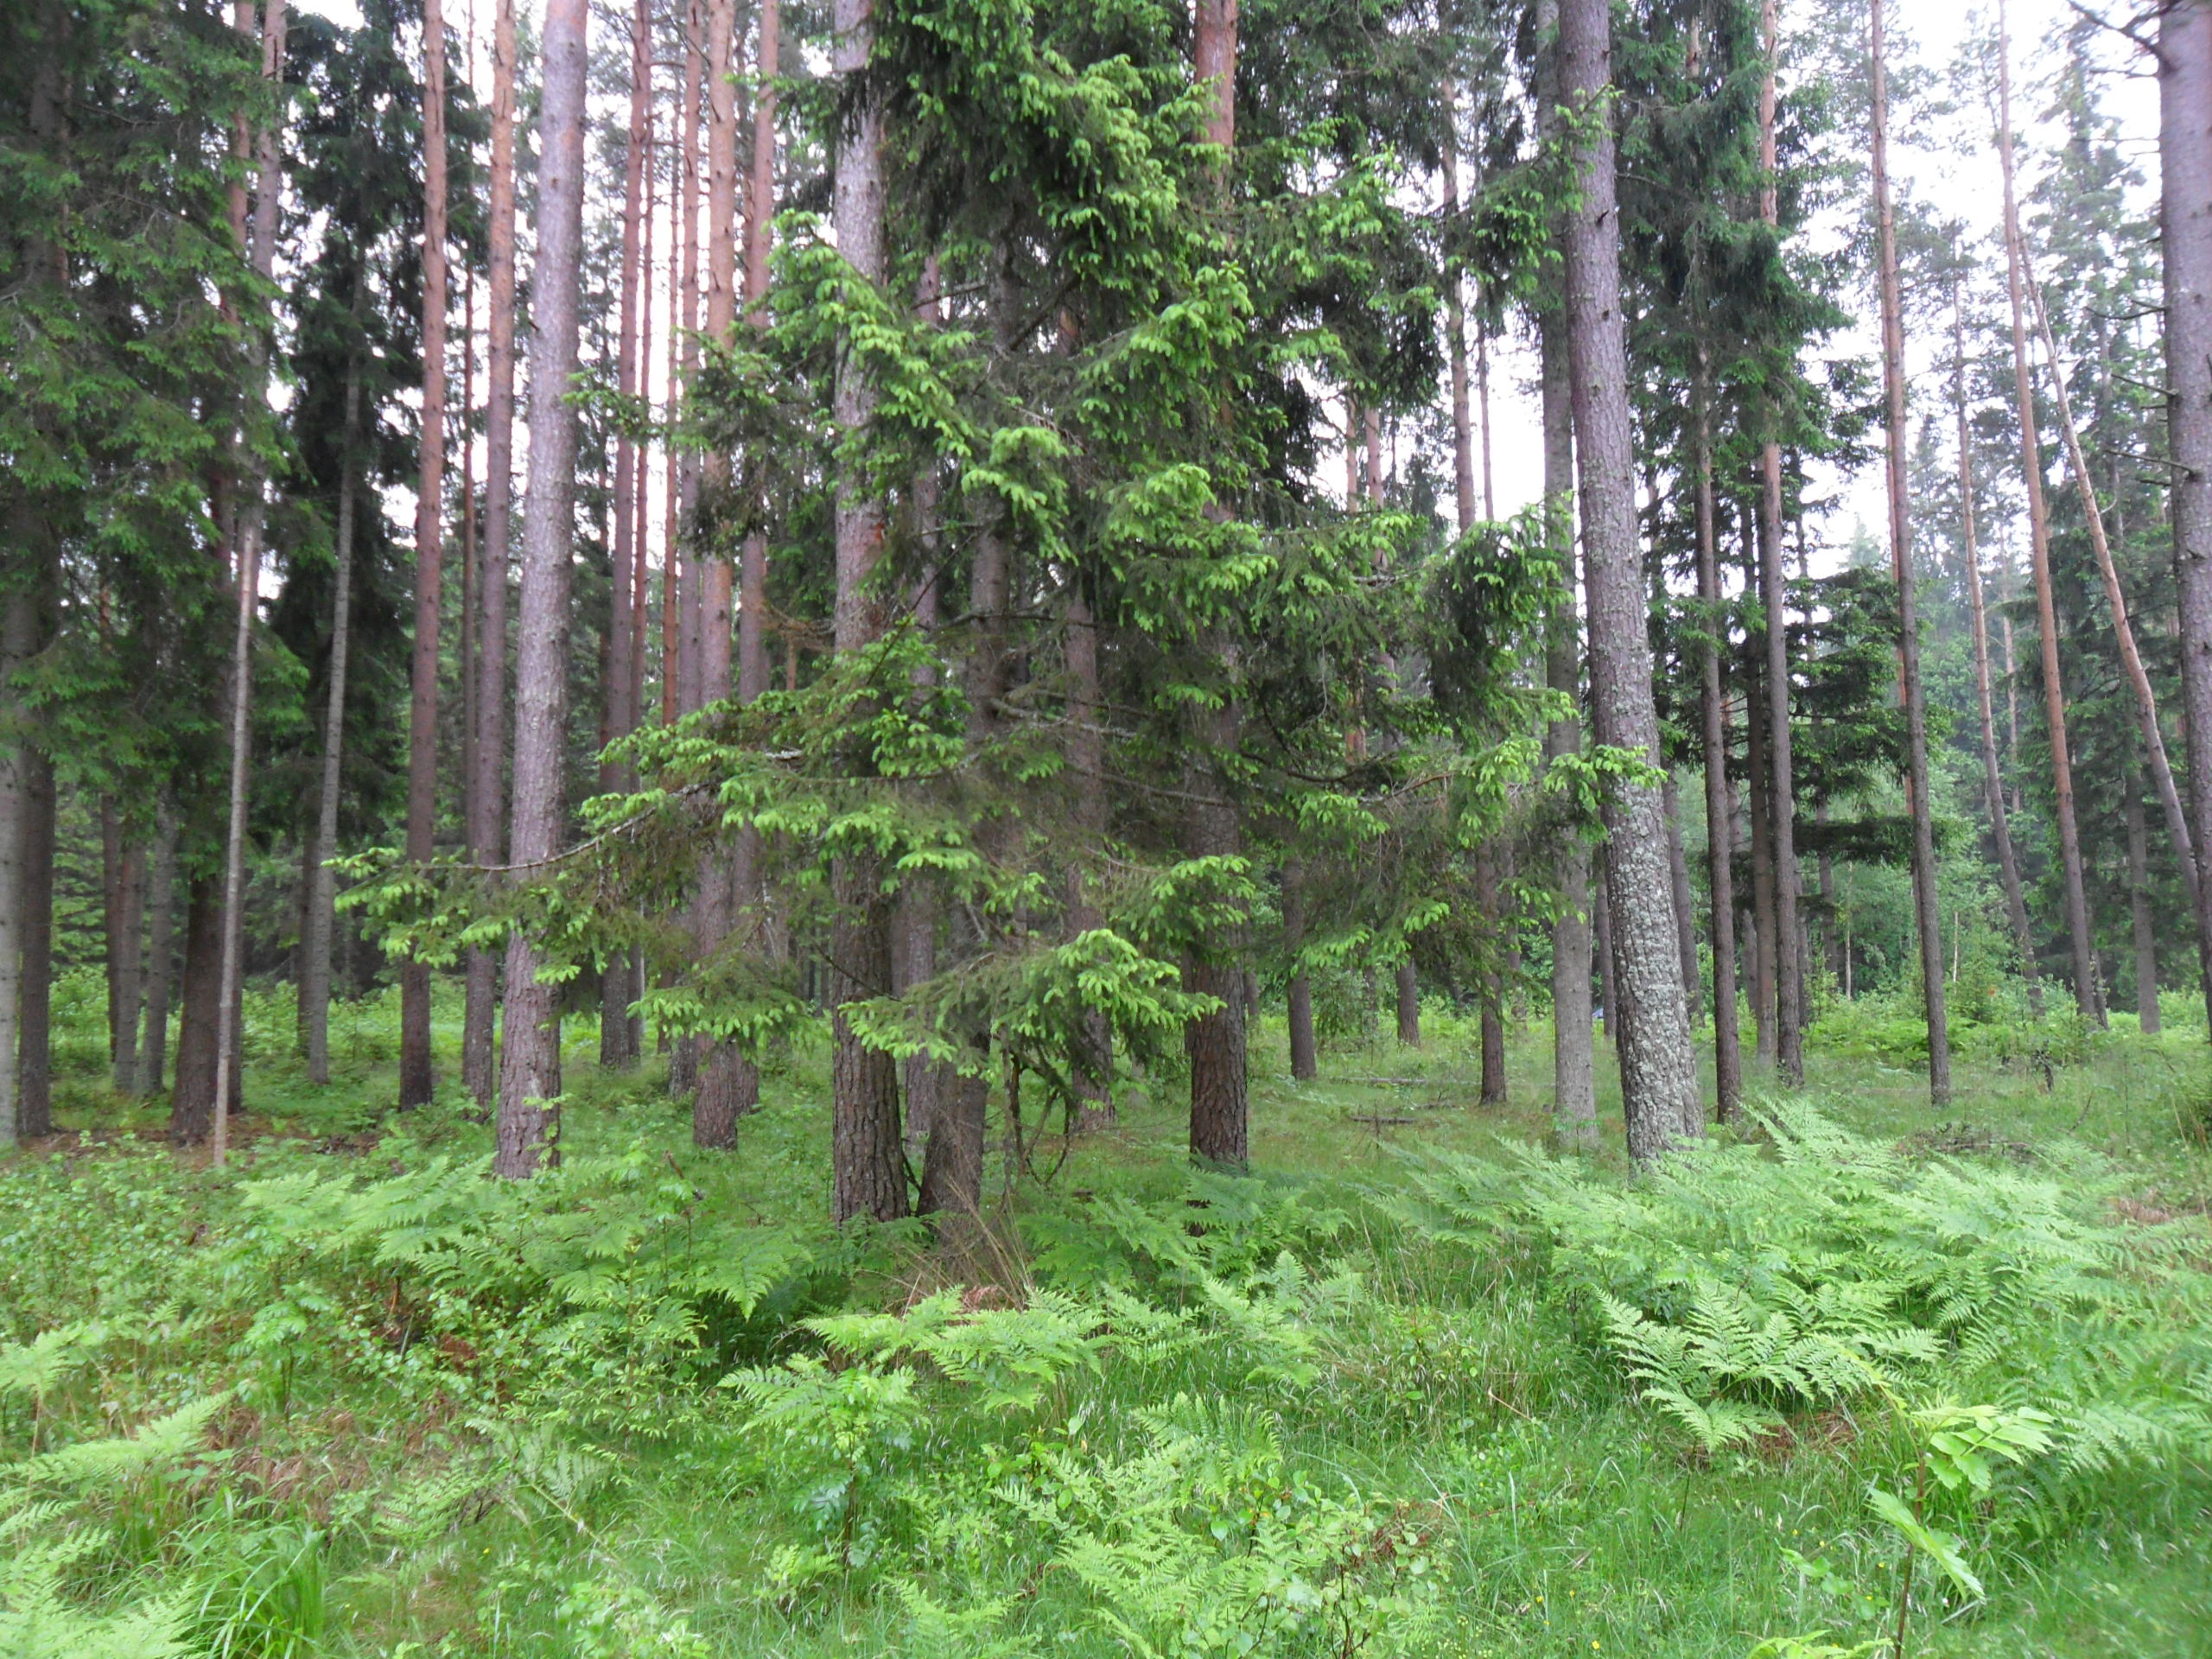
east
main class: Woodland
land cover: Spruce dominated coniferous woodland
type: hemiboreal forest and nemoral coniferous forest and mixed broadleaved-coniferous forest
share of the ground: > 75 %
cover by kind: coniferous forest trees 80 %, herbaceous plants 15 %, shrubs 5 %
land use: Forestry
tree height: > 5 m
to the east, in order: Spruce dominated coniferous woodland; Pine dominated mixed woodland; Electric lines; Other mixed woodland; Electric lines; Grass margins; Paved roads, cycling and walking lanes; Shruby margins; Other coniferous woodland
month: June
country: LV
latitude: 57.3284
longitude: 22.0552
